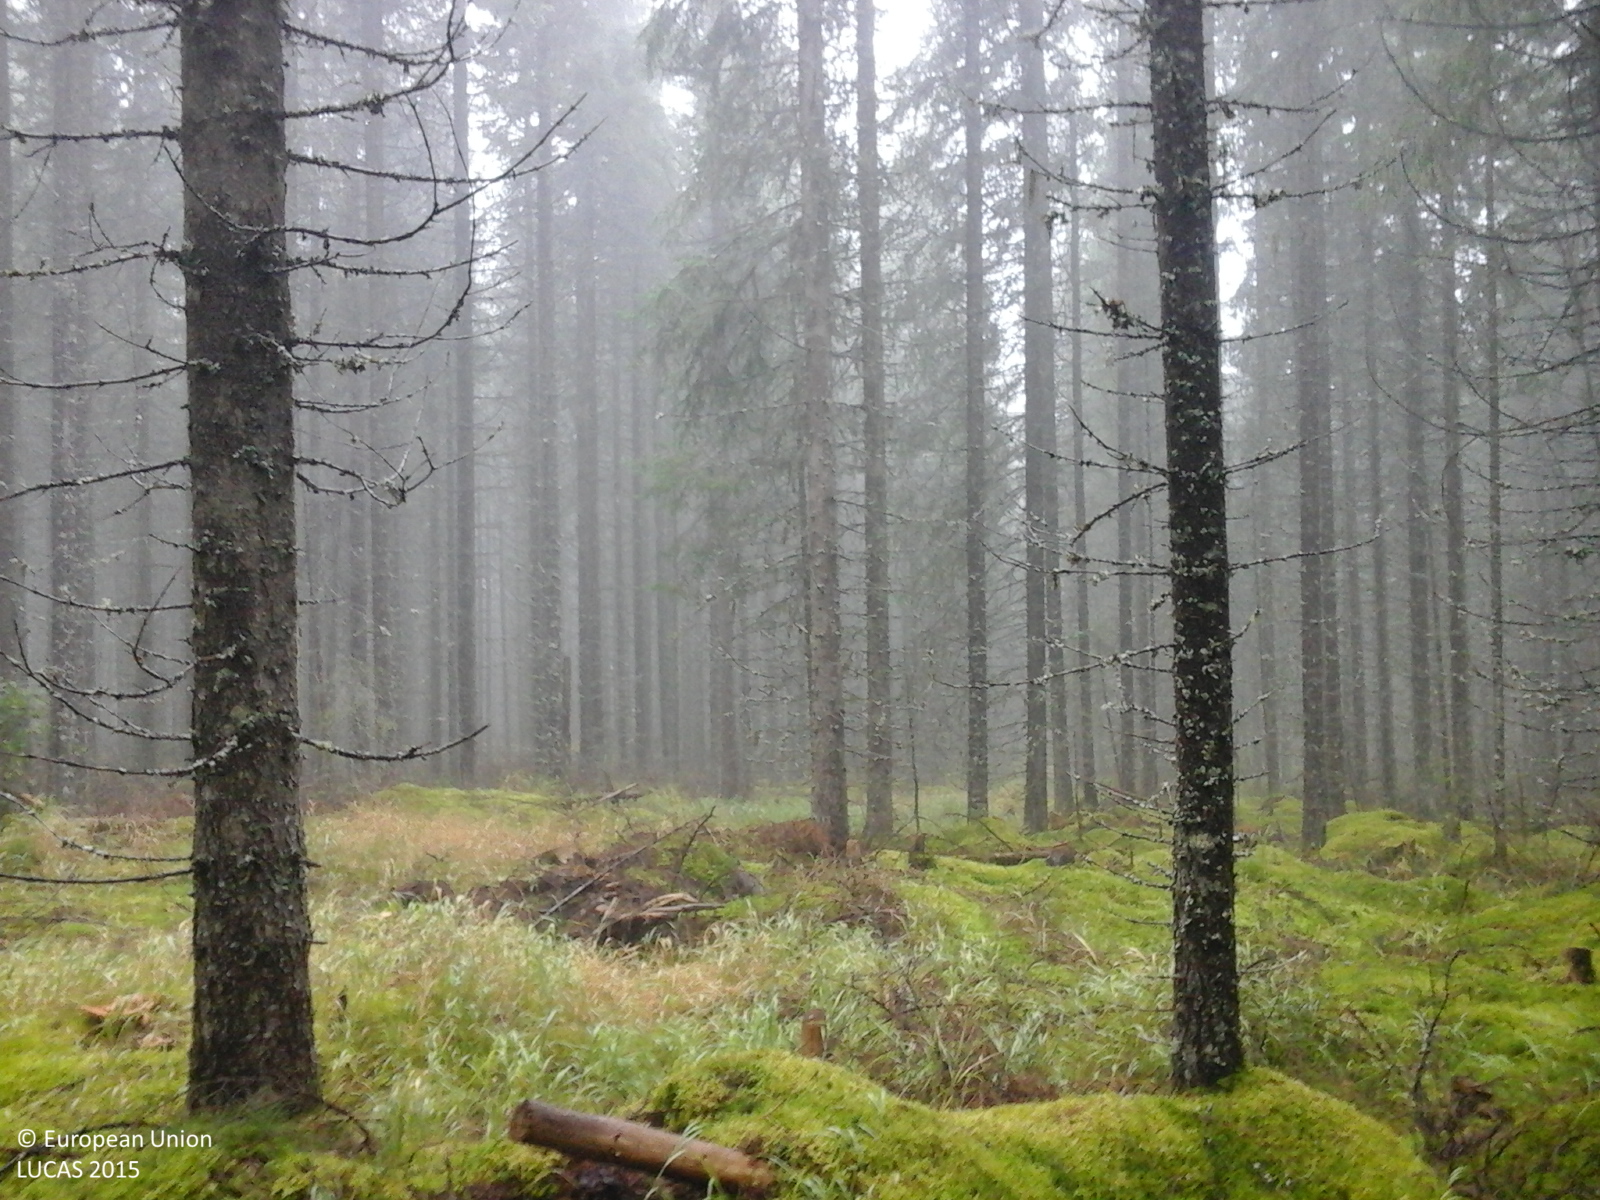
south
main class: Woodland
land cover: Spruce dominated coniferous woodland
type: alpine coniferous forest
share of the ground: > 75 %
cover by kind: coniferous forest trees 90 %, herbaceous plants 10 %
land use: Forestry
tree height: > 5 m
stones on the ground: > 50 %
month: September
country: RO
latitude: 45.6433
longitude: 23.7303
